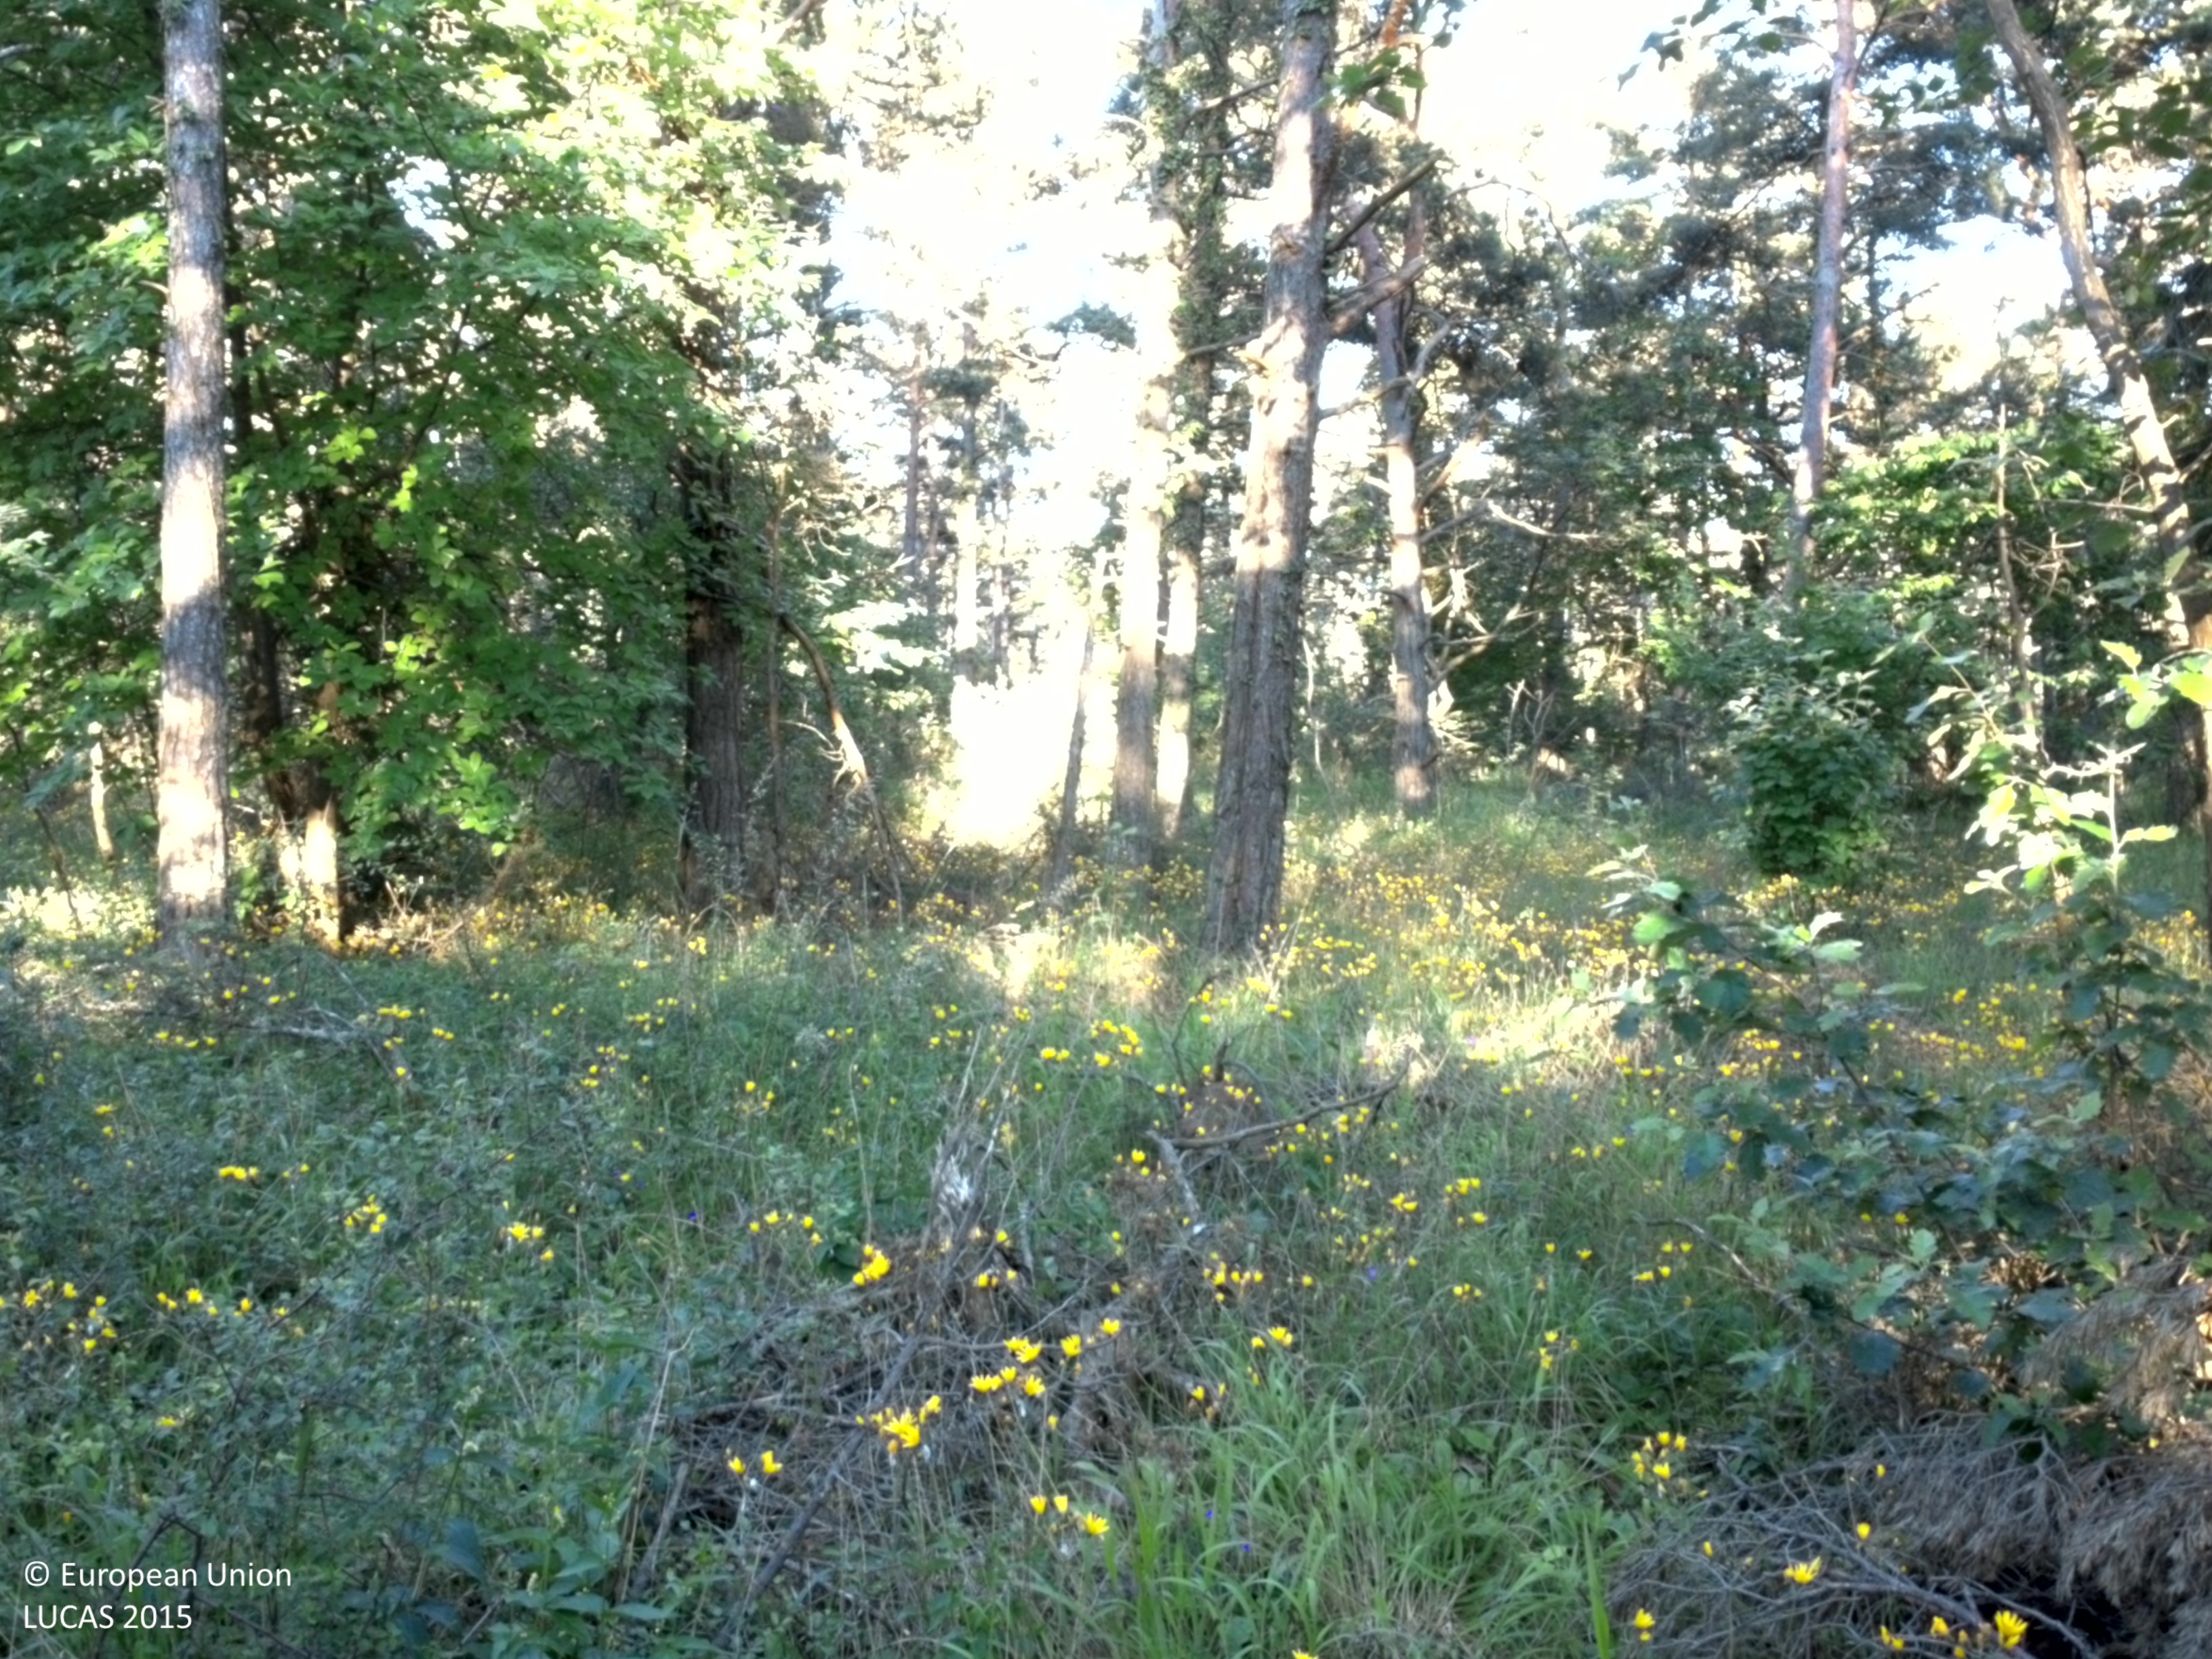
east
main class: Woodland
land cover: Pine dominated coniferous woodland
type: hemiboreal forest and nemoral coniferous forest and mixed broadleaved-coniferous forest
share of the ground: > 75 %
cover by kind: coniferous forest trees 65 %, herbaceous plants 20 %, broadleaved forest trees 10 %, shrubs 5 %
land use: Forestry
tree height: > 5 m
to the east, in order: Pine dominated coniferous woodland; Grassland with sparse tree/shrub cover; Fences; Grassland with sparse tree/shrub cover; Pine dominated coniferous woodland
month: June
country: SE
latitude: 57.6707
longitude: 18.3395
